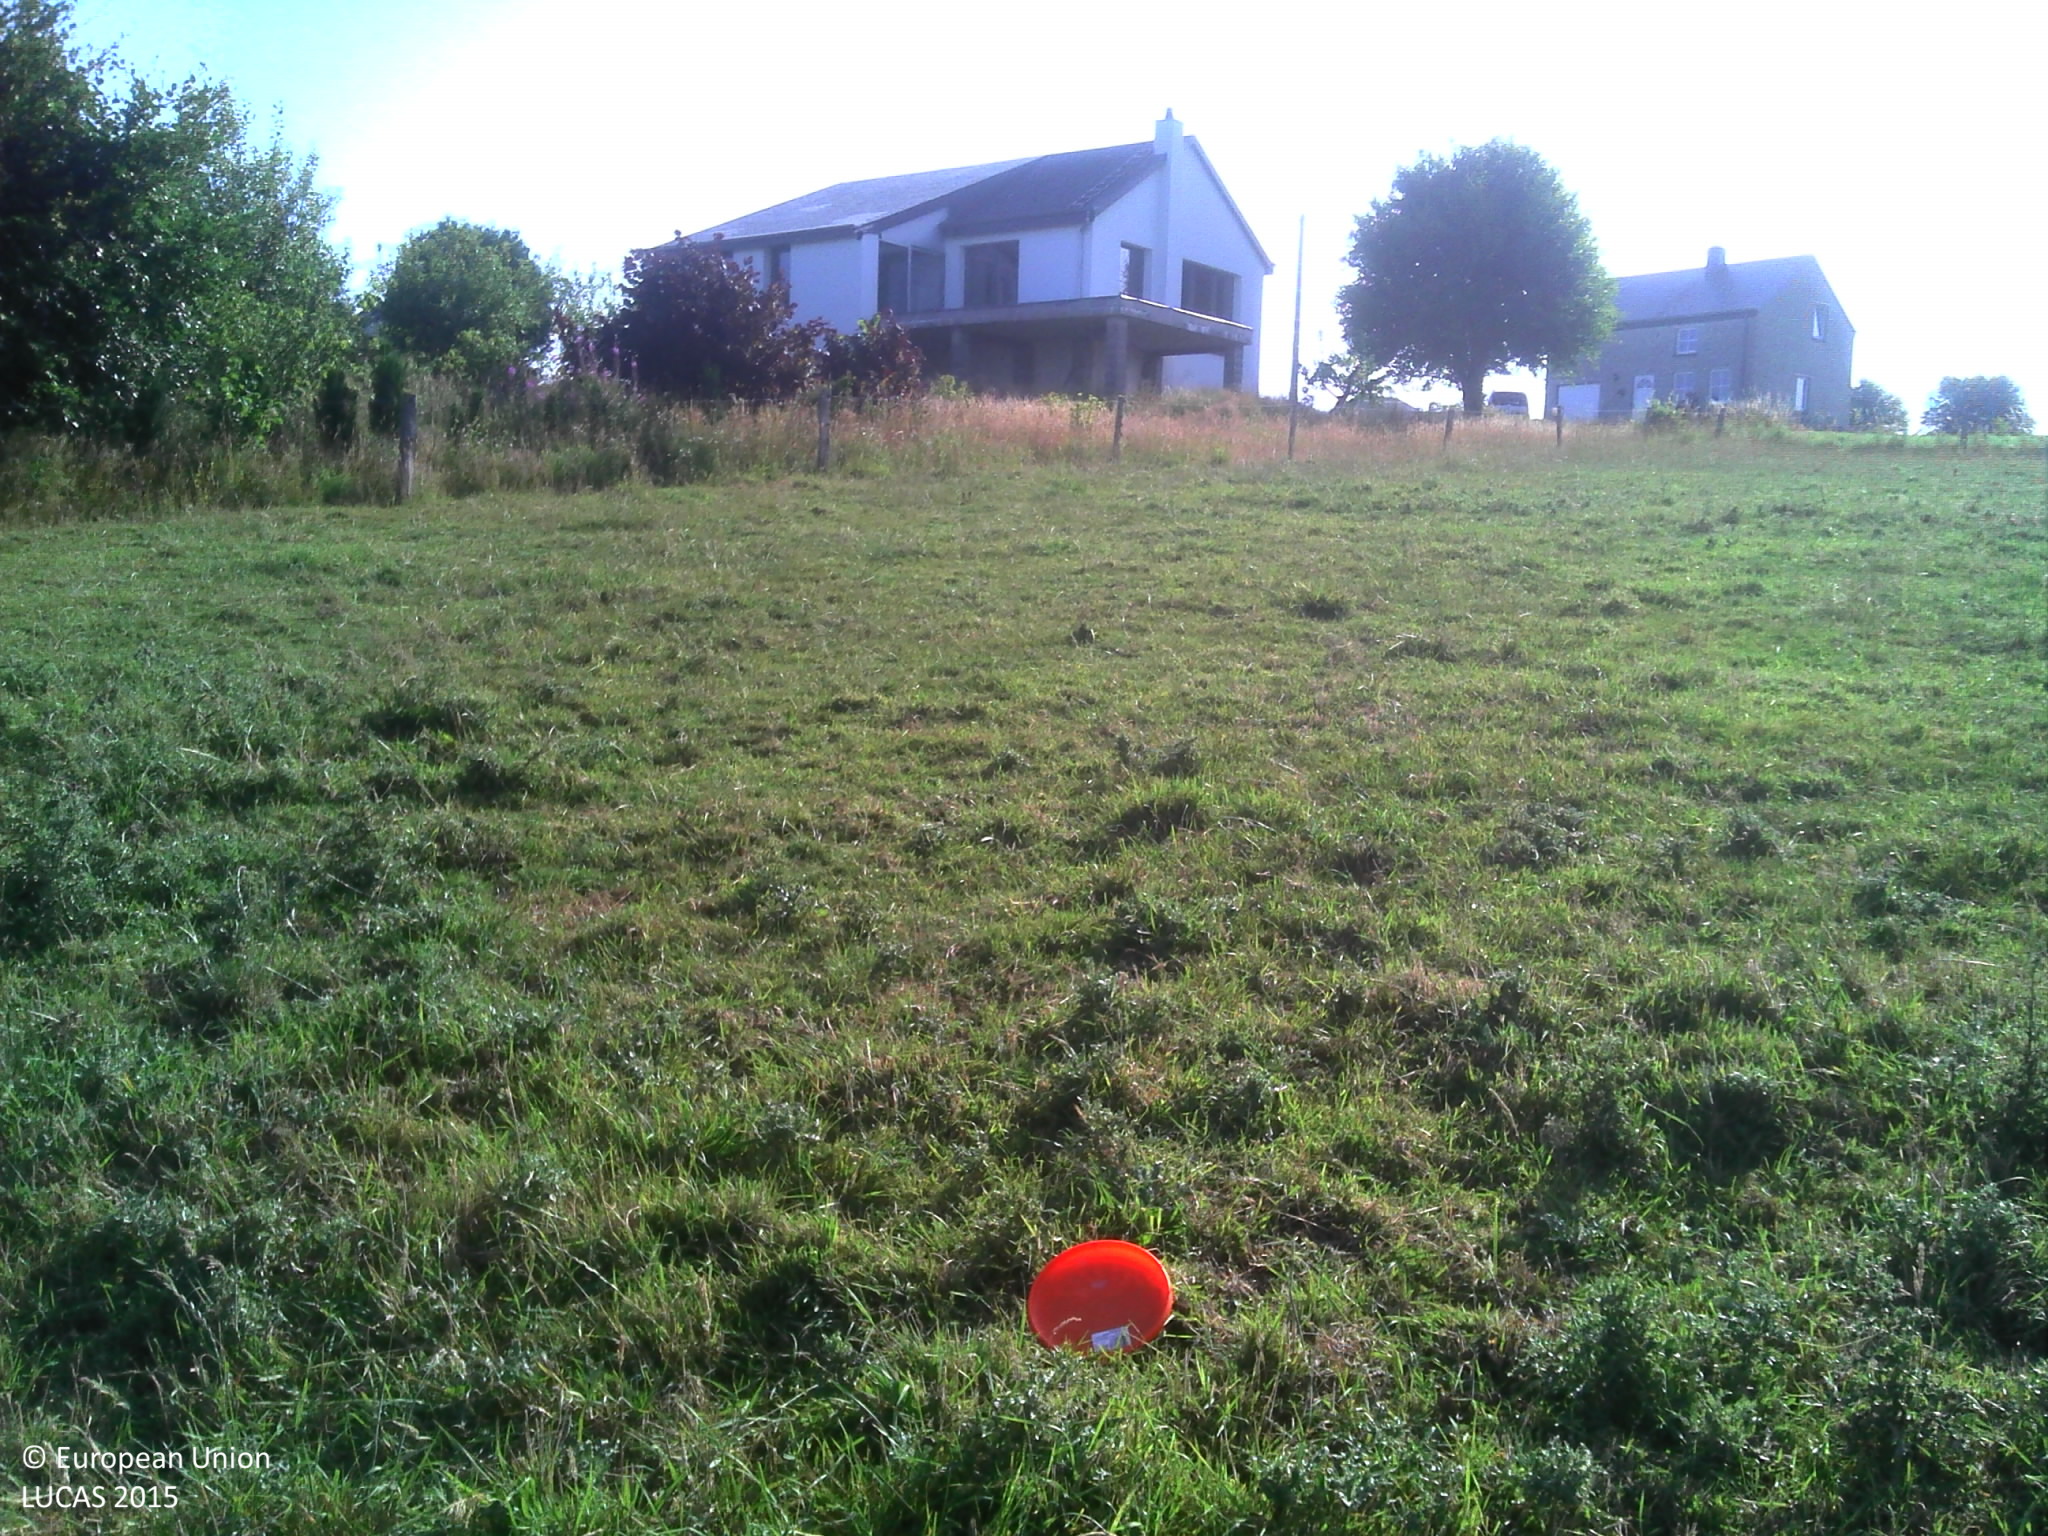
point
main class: Grassland
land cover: Grassland without tree/shrub cover
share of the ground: > 75 %
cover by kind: herbaceous plants 100 %
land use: Agriculture (excluding fallow land and kitchen gardens)
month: July
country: BE
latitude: 49.9545
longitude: 5.5802
